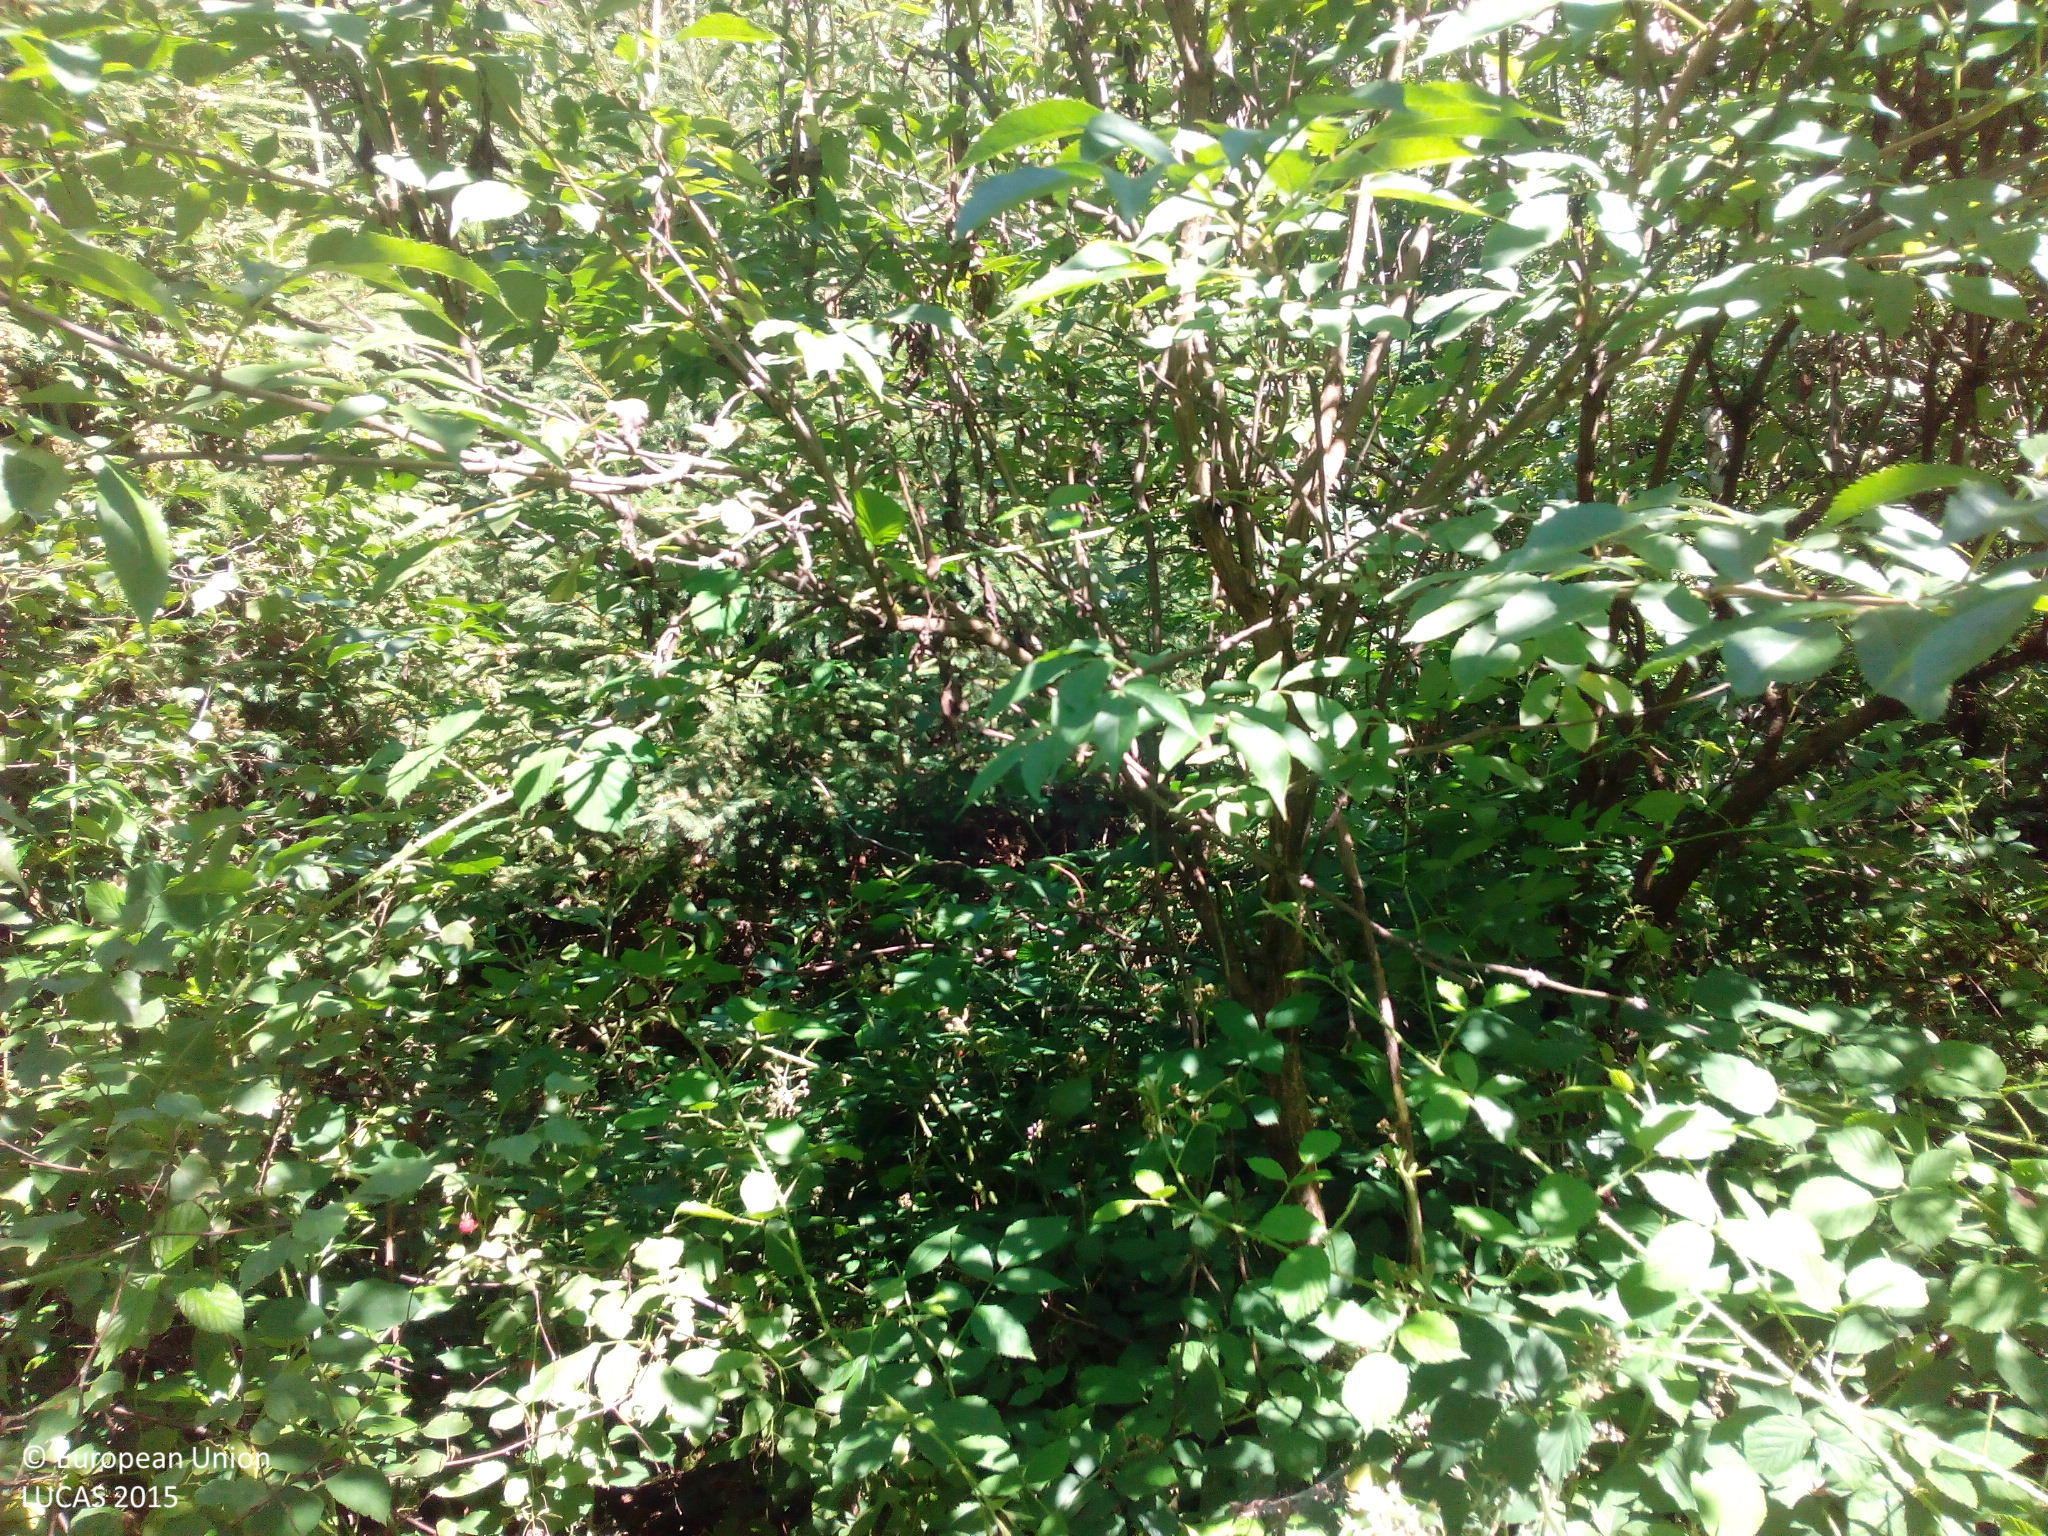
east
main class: Woodland
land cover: Spruce dominated coniferous woodland
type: hemiboreal forest and nemoral coniferous forest and mixed broadleaved-coniferous forest
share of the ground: > 75 %
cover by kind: coniferous forest trees 85 %, broadleaved forest trees 15 %
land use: Forestry
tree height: < 5 m
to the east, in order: Spruce dominated coniferous woodland; Tracks; Spruce dominated coniferous woodland
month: July
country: DE
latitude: 48.7093
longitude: 9.9593
